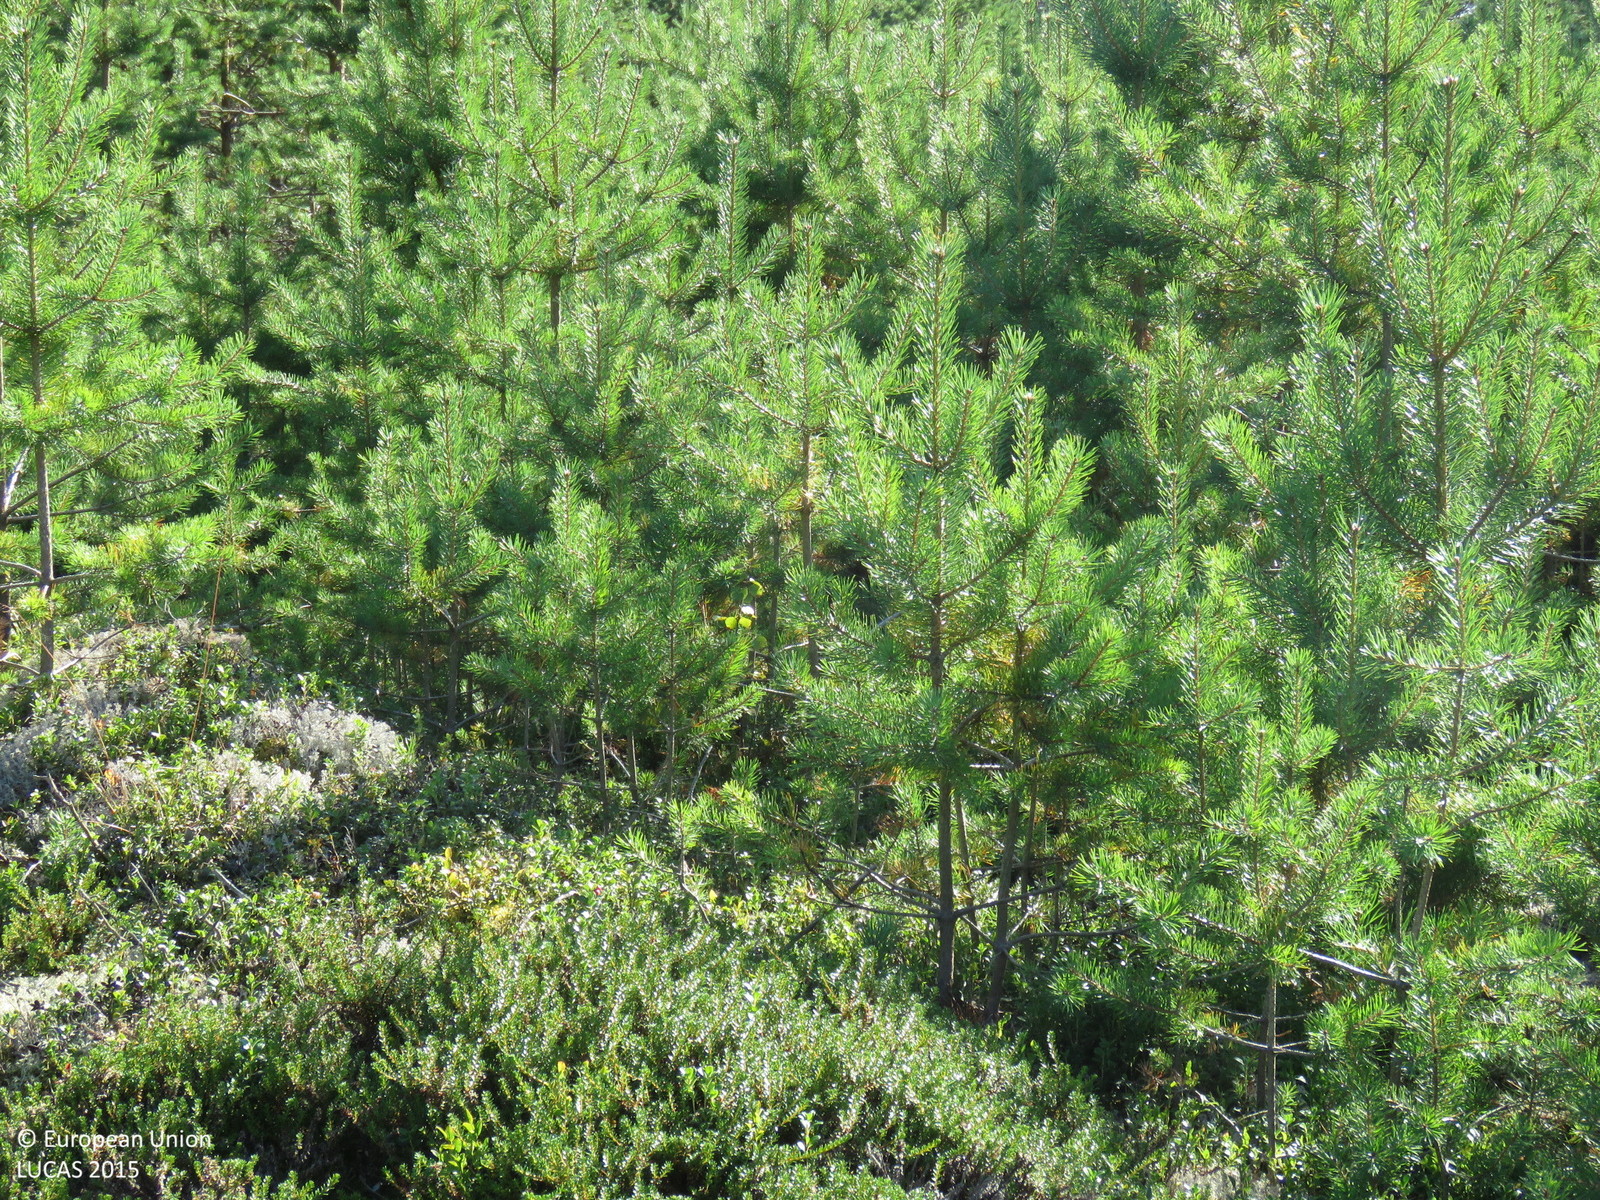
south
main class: Woodland
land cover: Pine dominated coniferous woodland
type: boreal forest
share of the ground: > 75 %
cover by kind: coniferous forest trees 80 %, shrubs 10 %, lichens and mosses 10 %
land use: Forestry
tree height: > 5 m
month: August
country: FI
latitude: 65.0607
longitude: 24.8413
